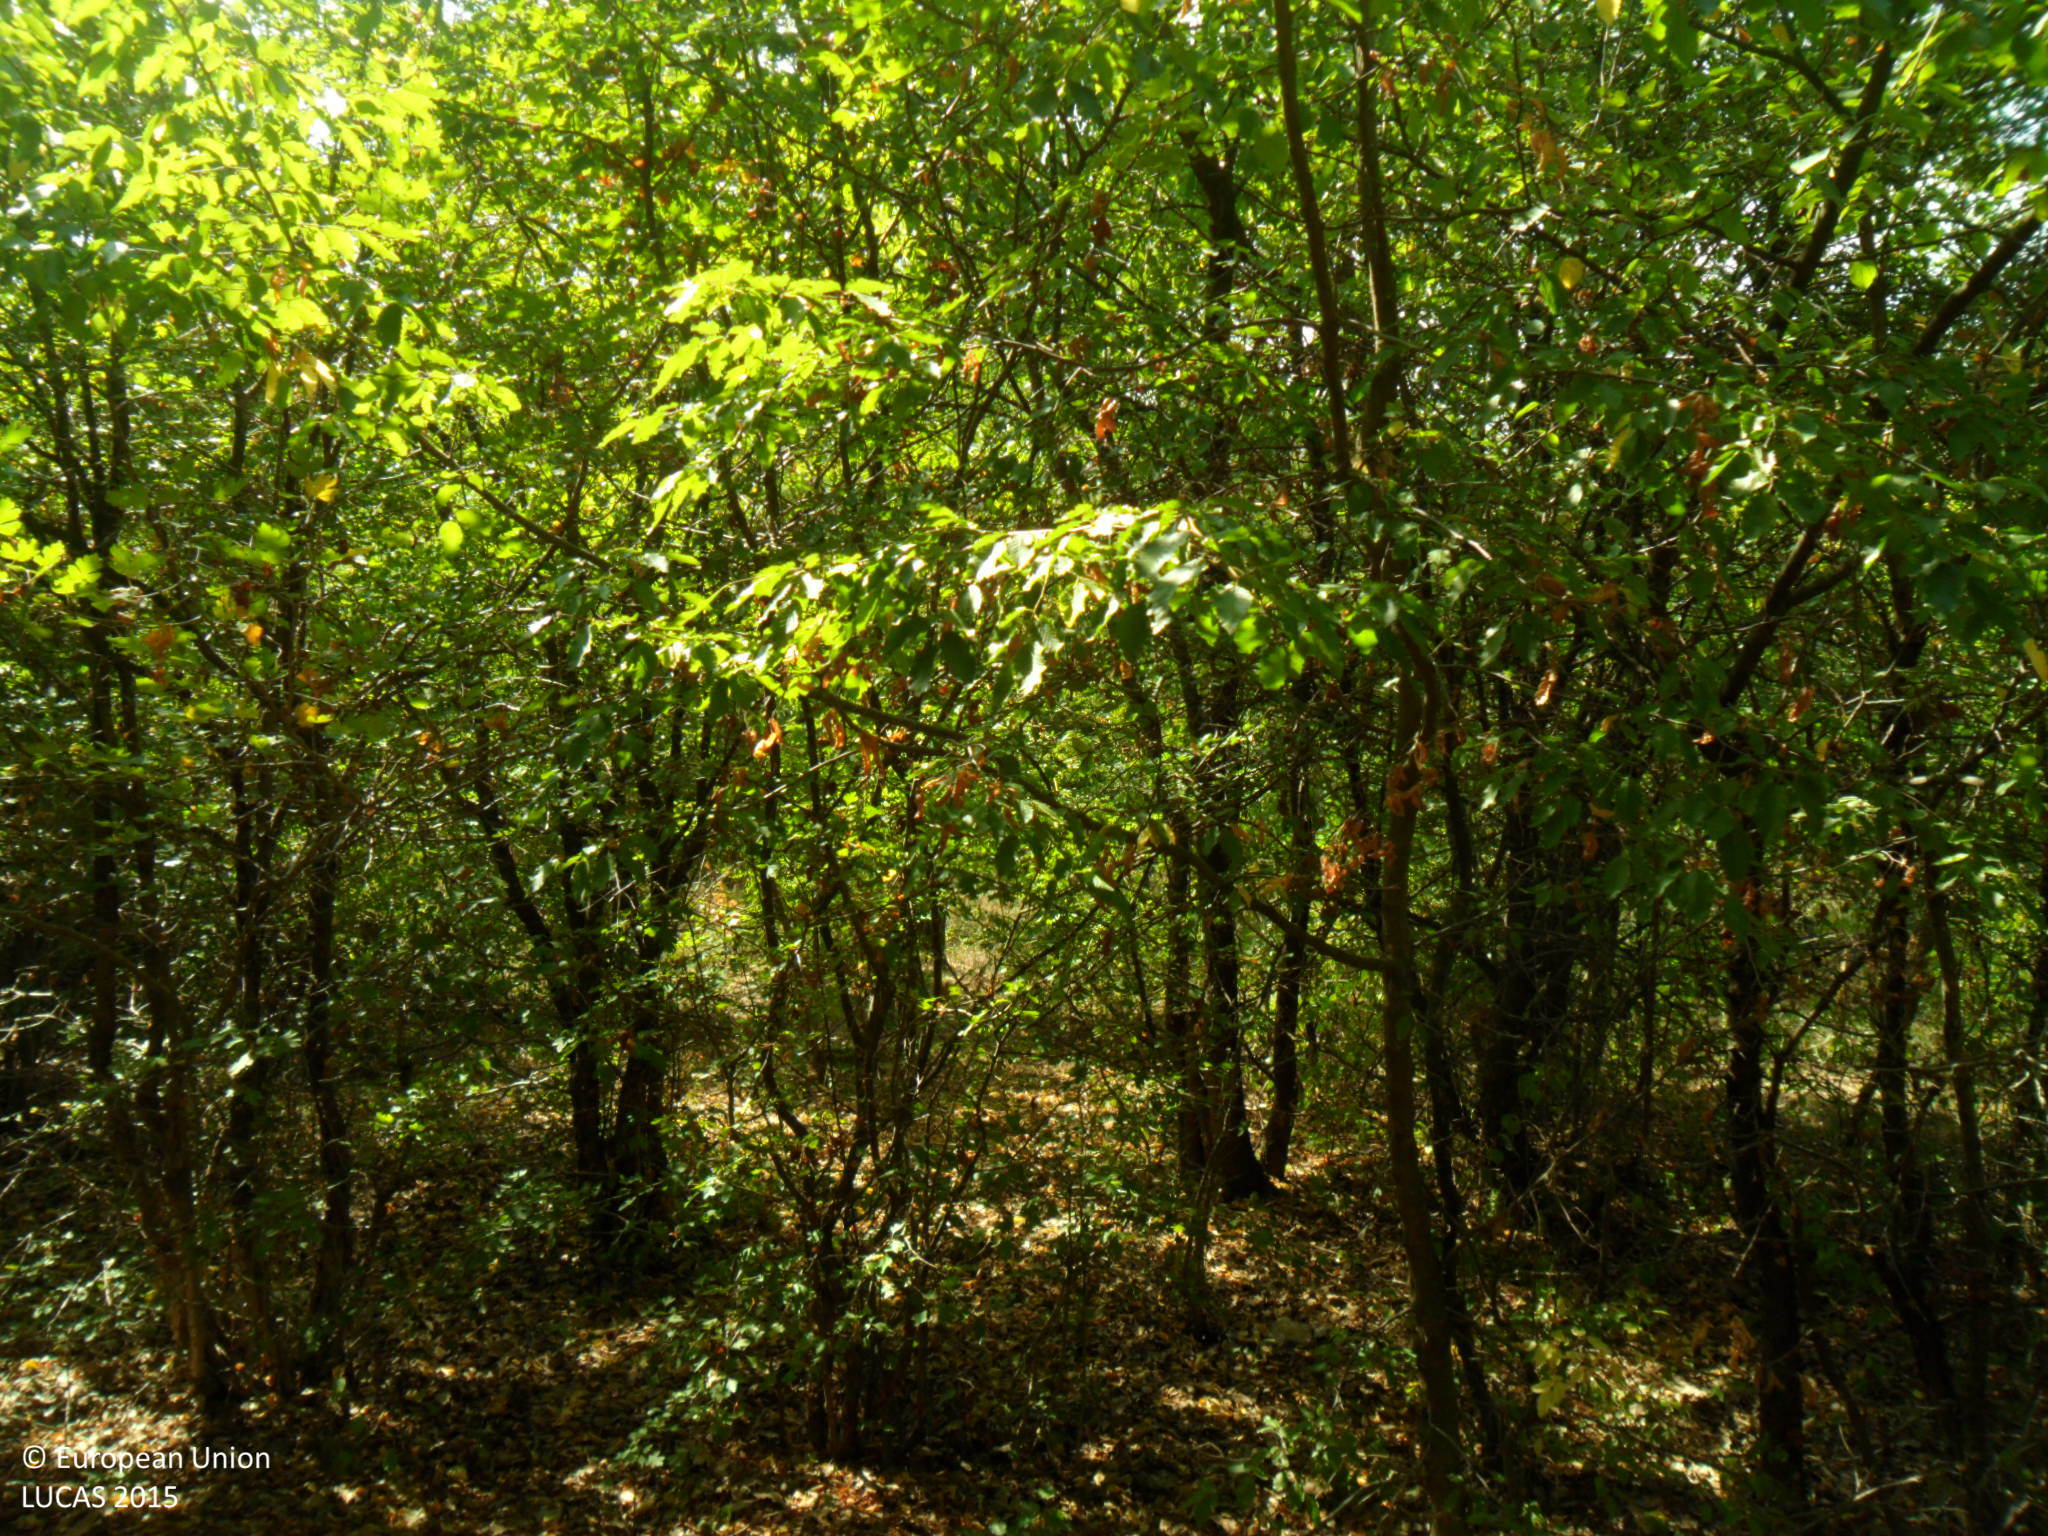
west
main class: Woodland
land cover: Broadleaved woodland
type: beech forest
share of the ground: > 75 %
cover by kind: broadleaved forest trees 90 %, herbaceous plants 10 %
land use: Forestry
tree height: > 5 m
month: August
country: BG
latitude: 43.5985
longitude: 27.1048
